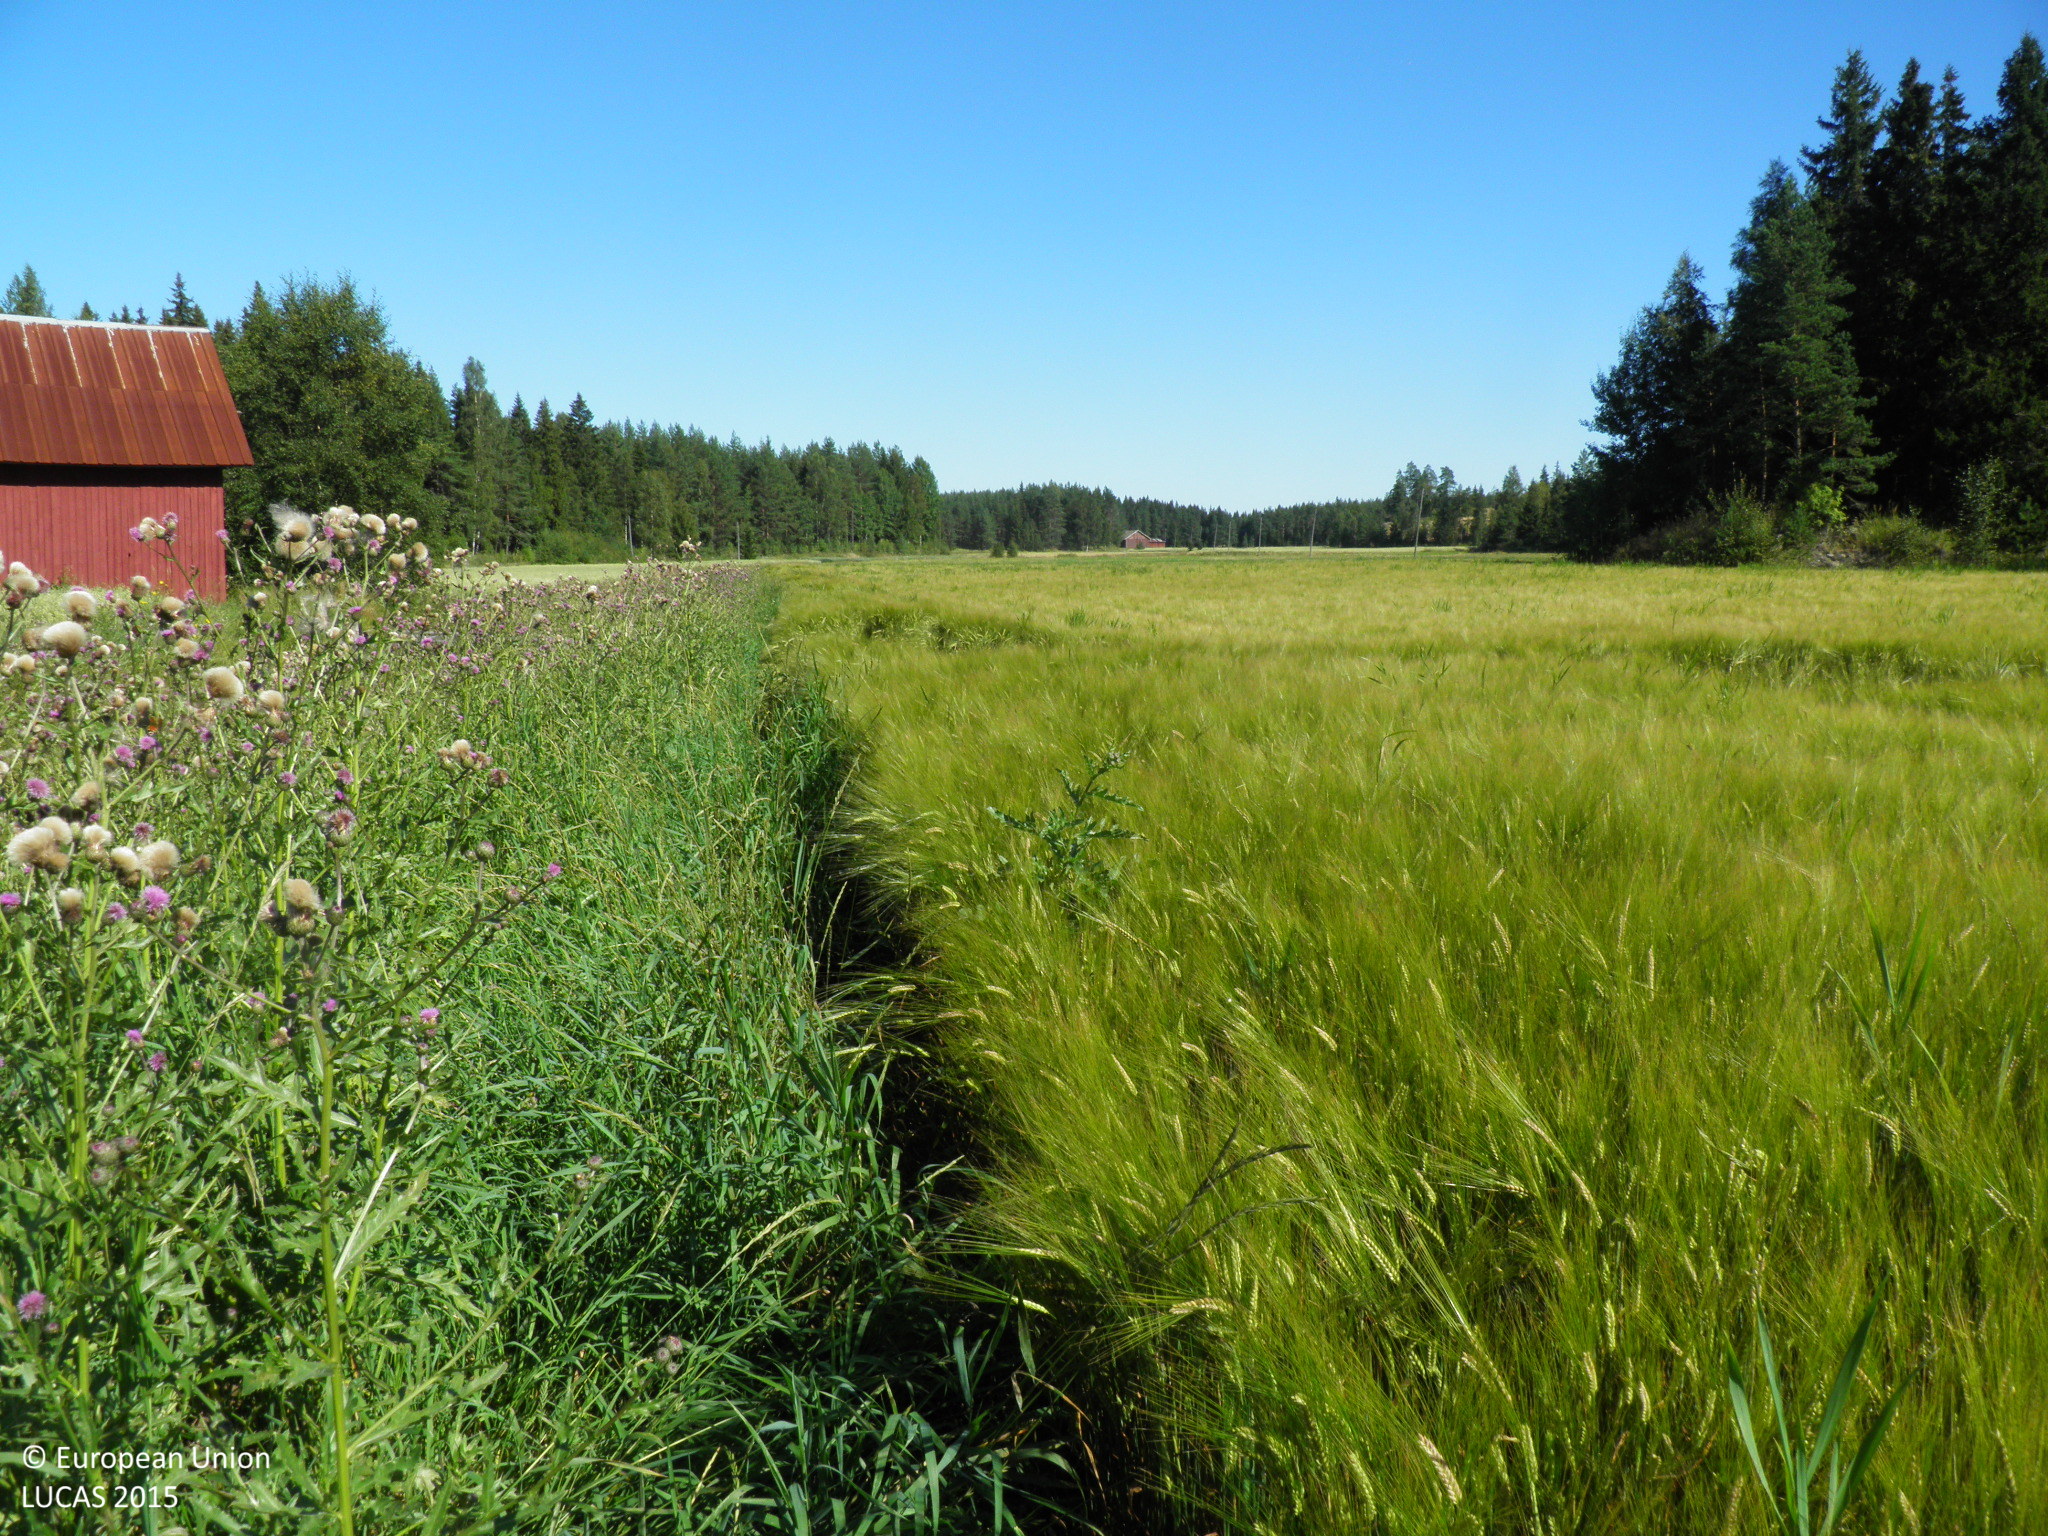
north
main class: Cropland
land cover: Barley
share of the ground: > 75 %
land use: Agriculture (excluding fallow land and kitchen gardens)
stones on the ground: < 10 %
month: August
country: FI
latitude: 60.7631
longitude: 21.9731
